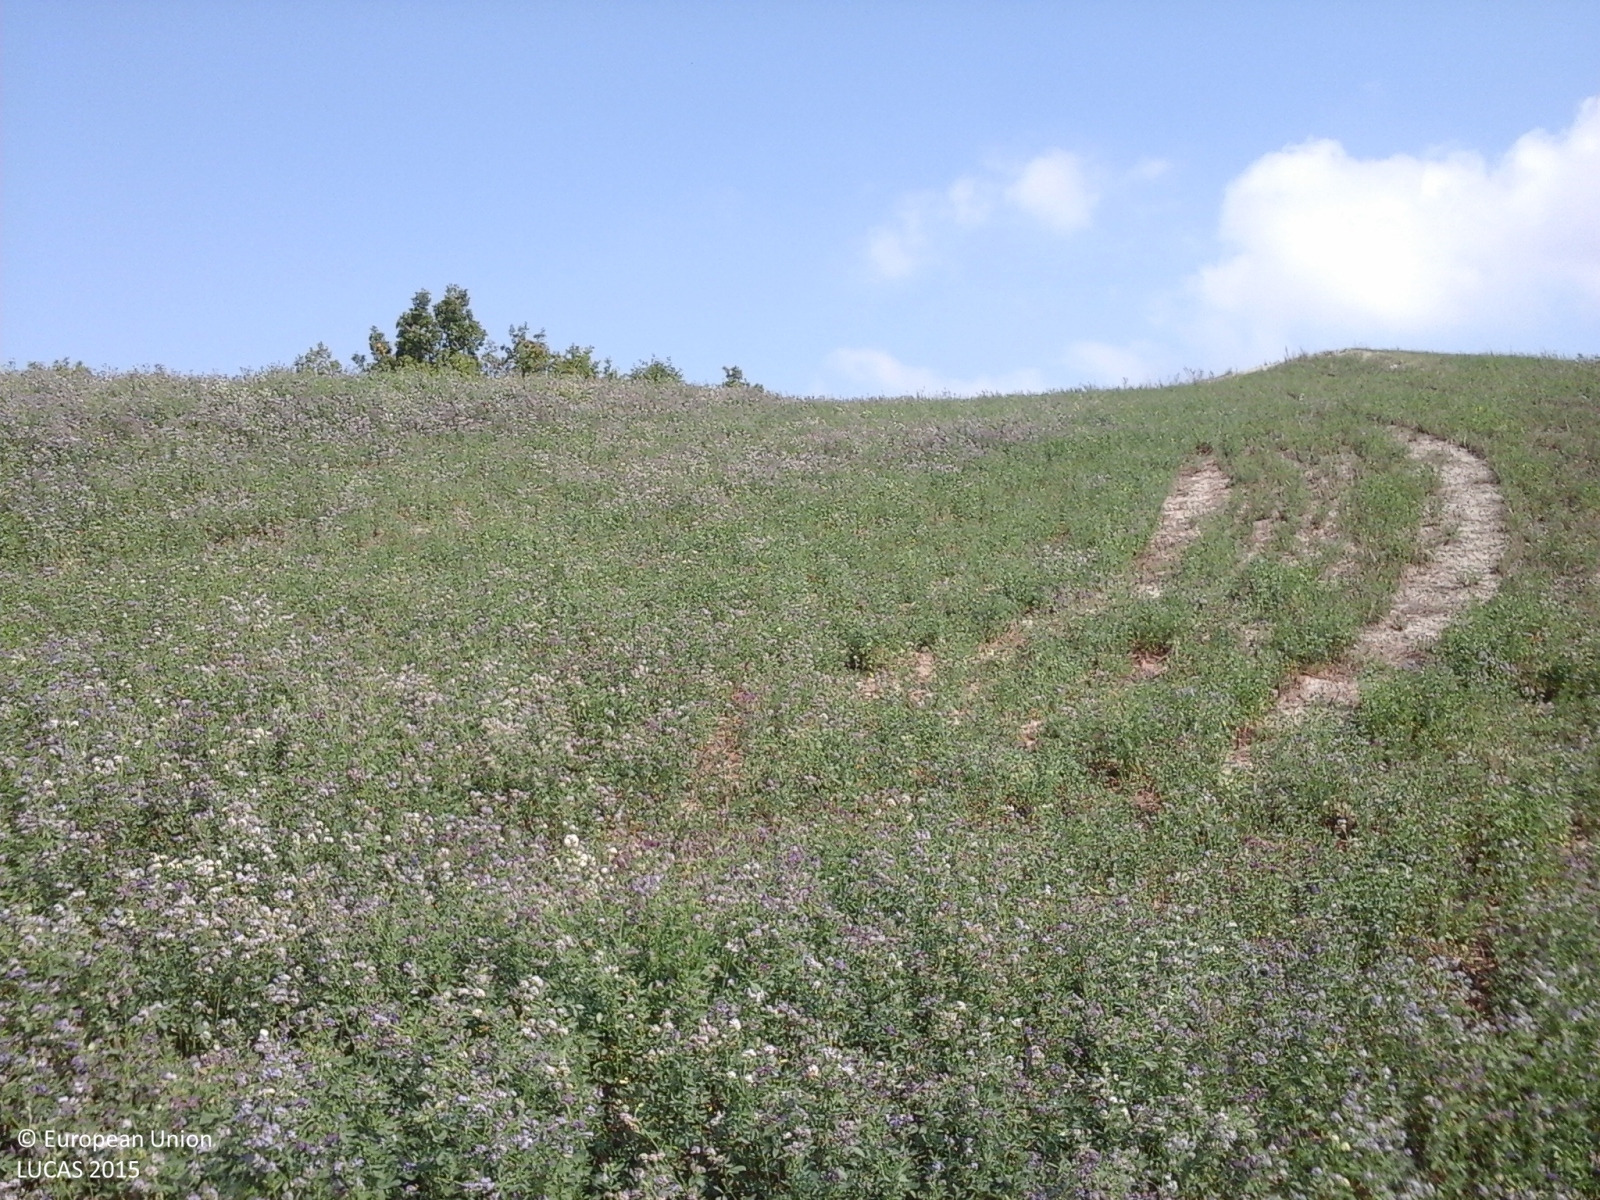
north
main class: Cropland
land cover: Lucerne
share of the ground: > 75 %
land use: Agriculture (excluding fallow land and kitchen gardens)
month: August
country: IT
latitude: 44.9063
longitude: 9.1784
